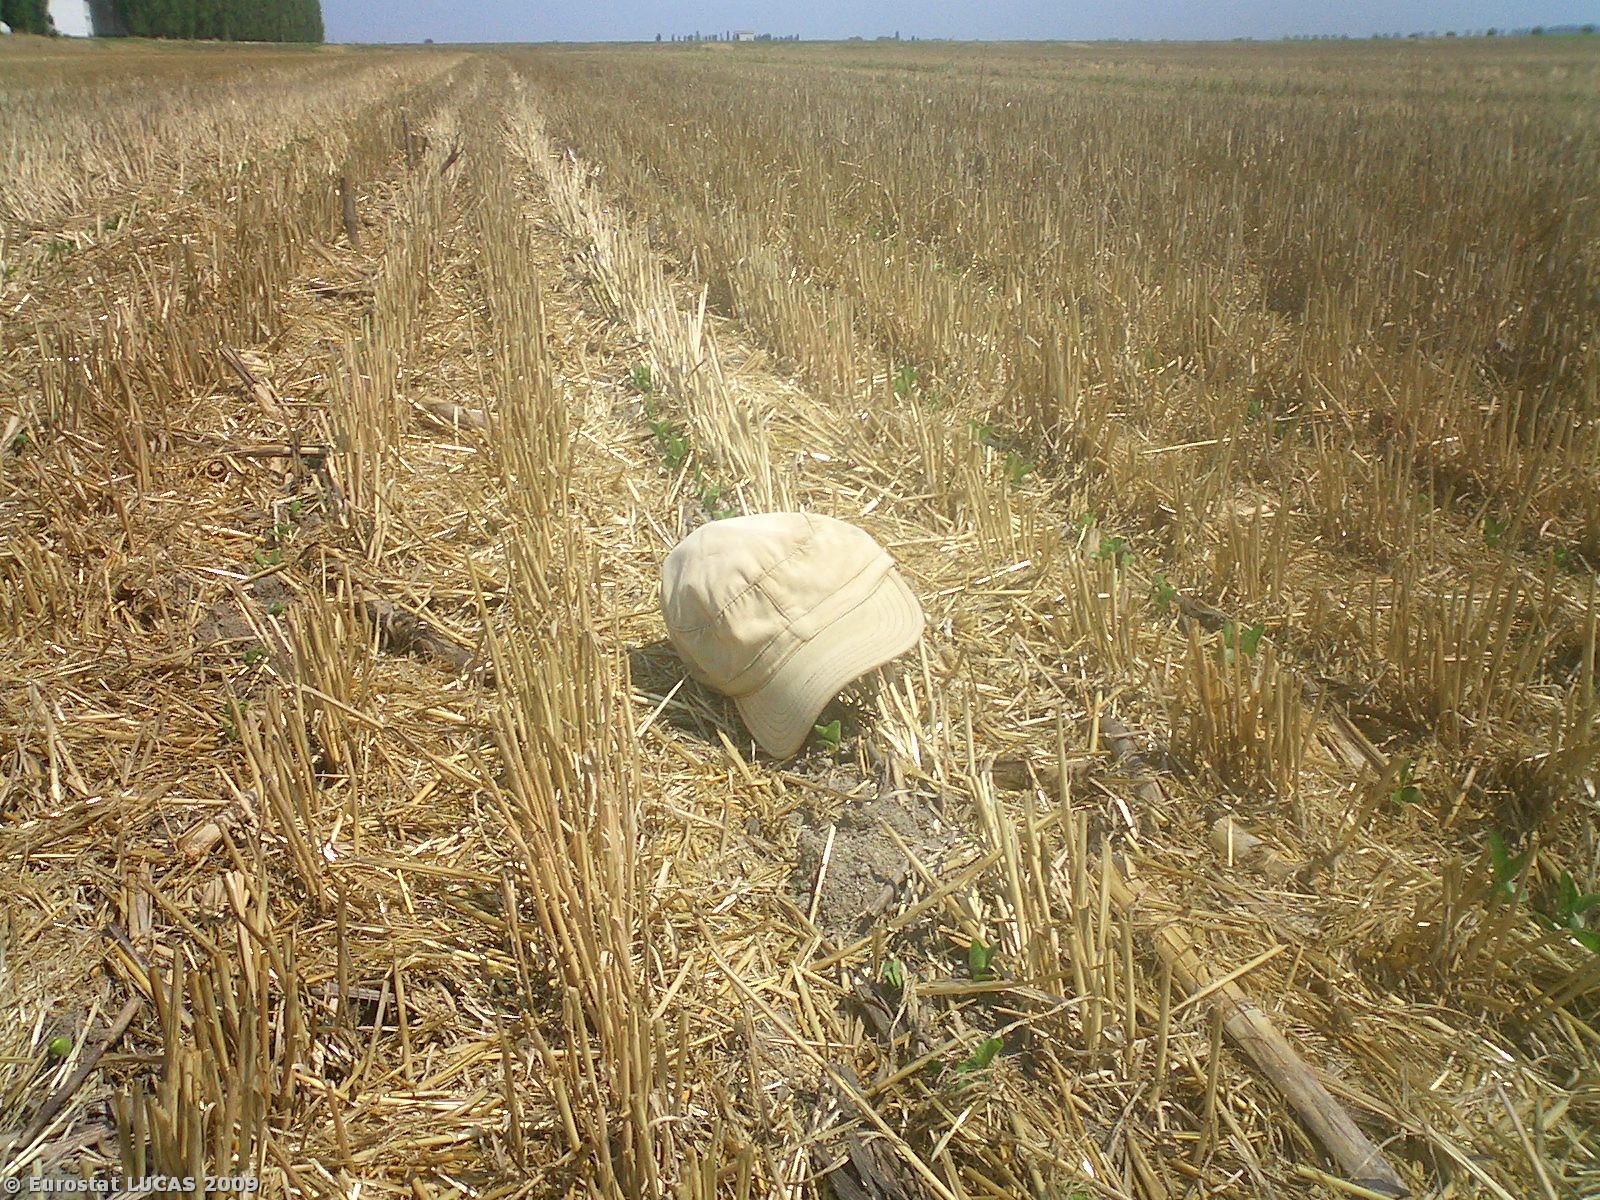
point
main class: Cropland
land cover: Soya
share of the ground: < 10 %
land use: Agriculture (excluding fallow land and kitchen gardens)
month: July
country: IT
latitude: 44.8898
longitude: 12.0347
